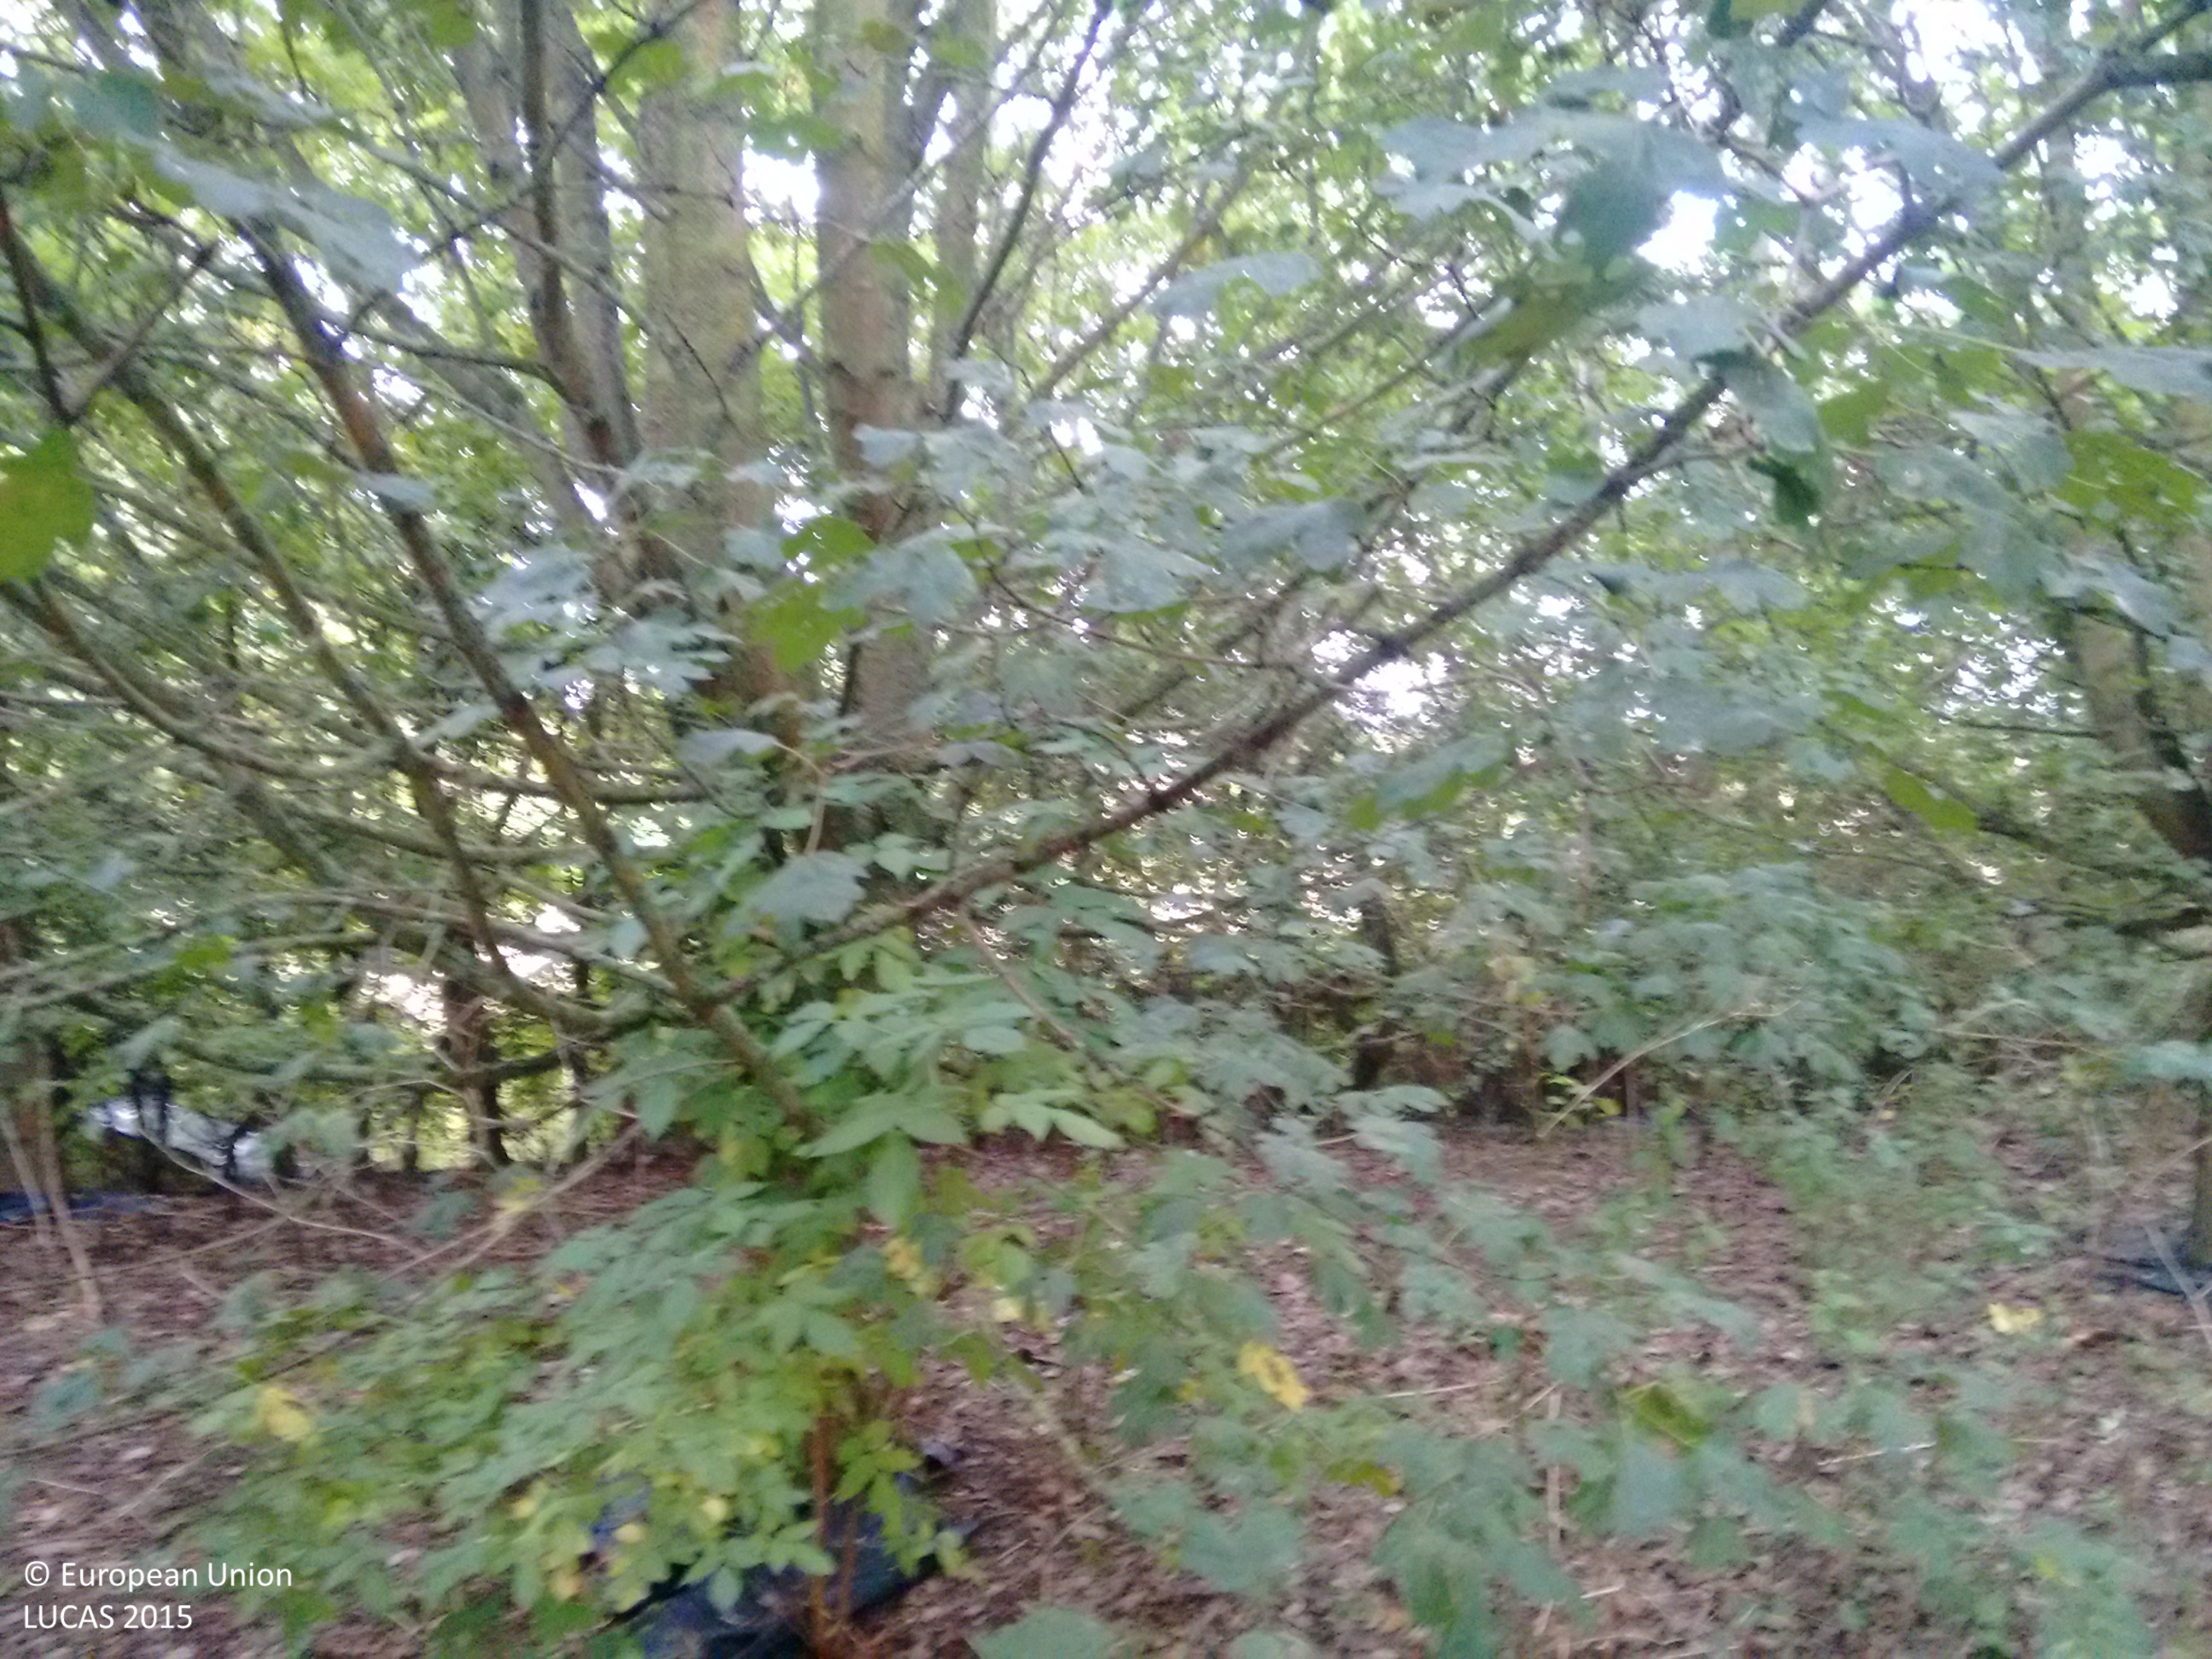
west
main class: Woodland
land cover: Broadleaved woodland
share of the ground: > 75 %
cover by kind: broadleaved forest trees 75 %, shrubs 25 %
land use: Semi-natural and natural areas not in use
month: September
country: GB
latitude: 52.2679
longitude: 0.2842
